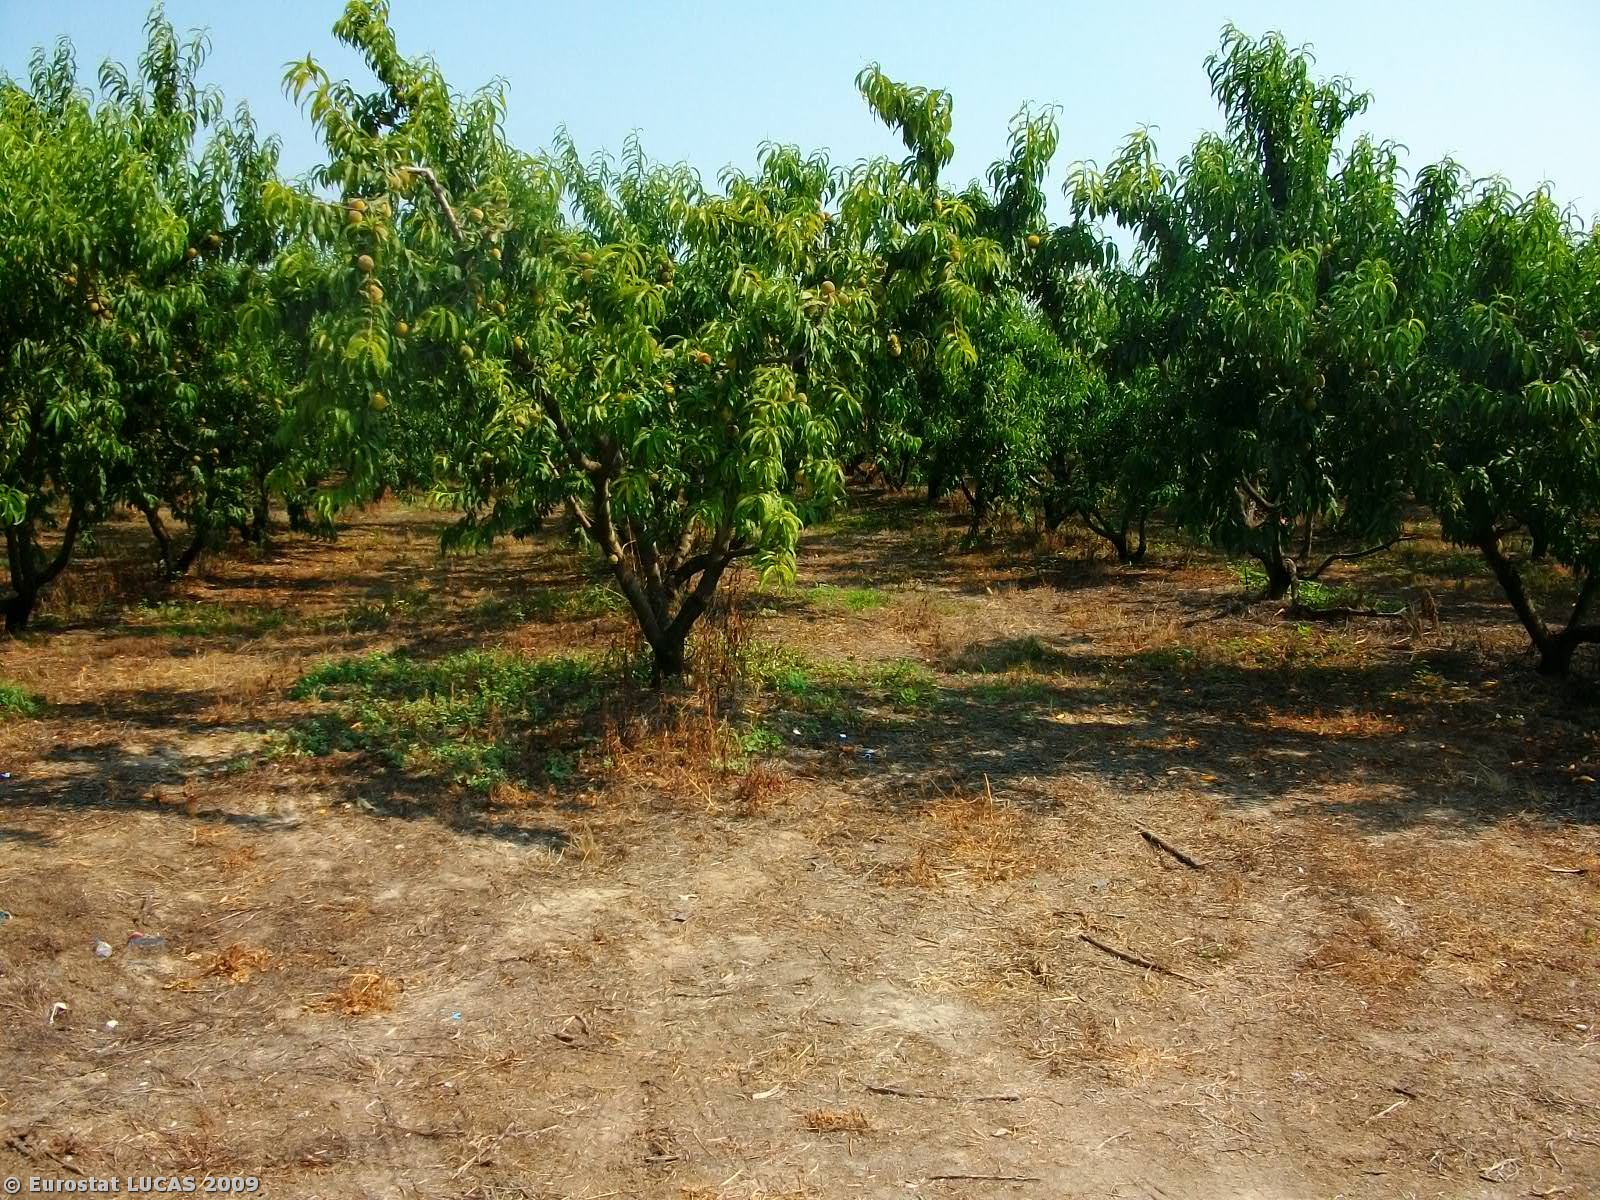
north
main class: Artificial land
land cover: Non built-up linear features
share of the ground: > 75 %
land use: Road transport
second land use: Agriculture (excluding fallow land and kitchen gardens)
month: July
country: GR
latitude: 40.2929
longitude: 22.5983
